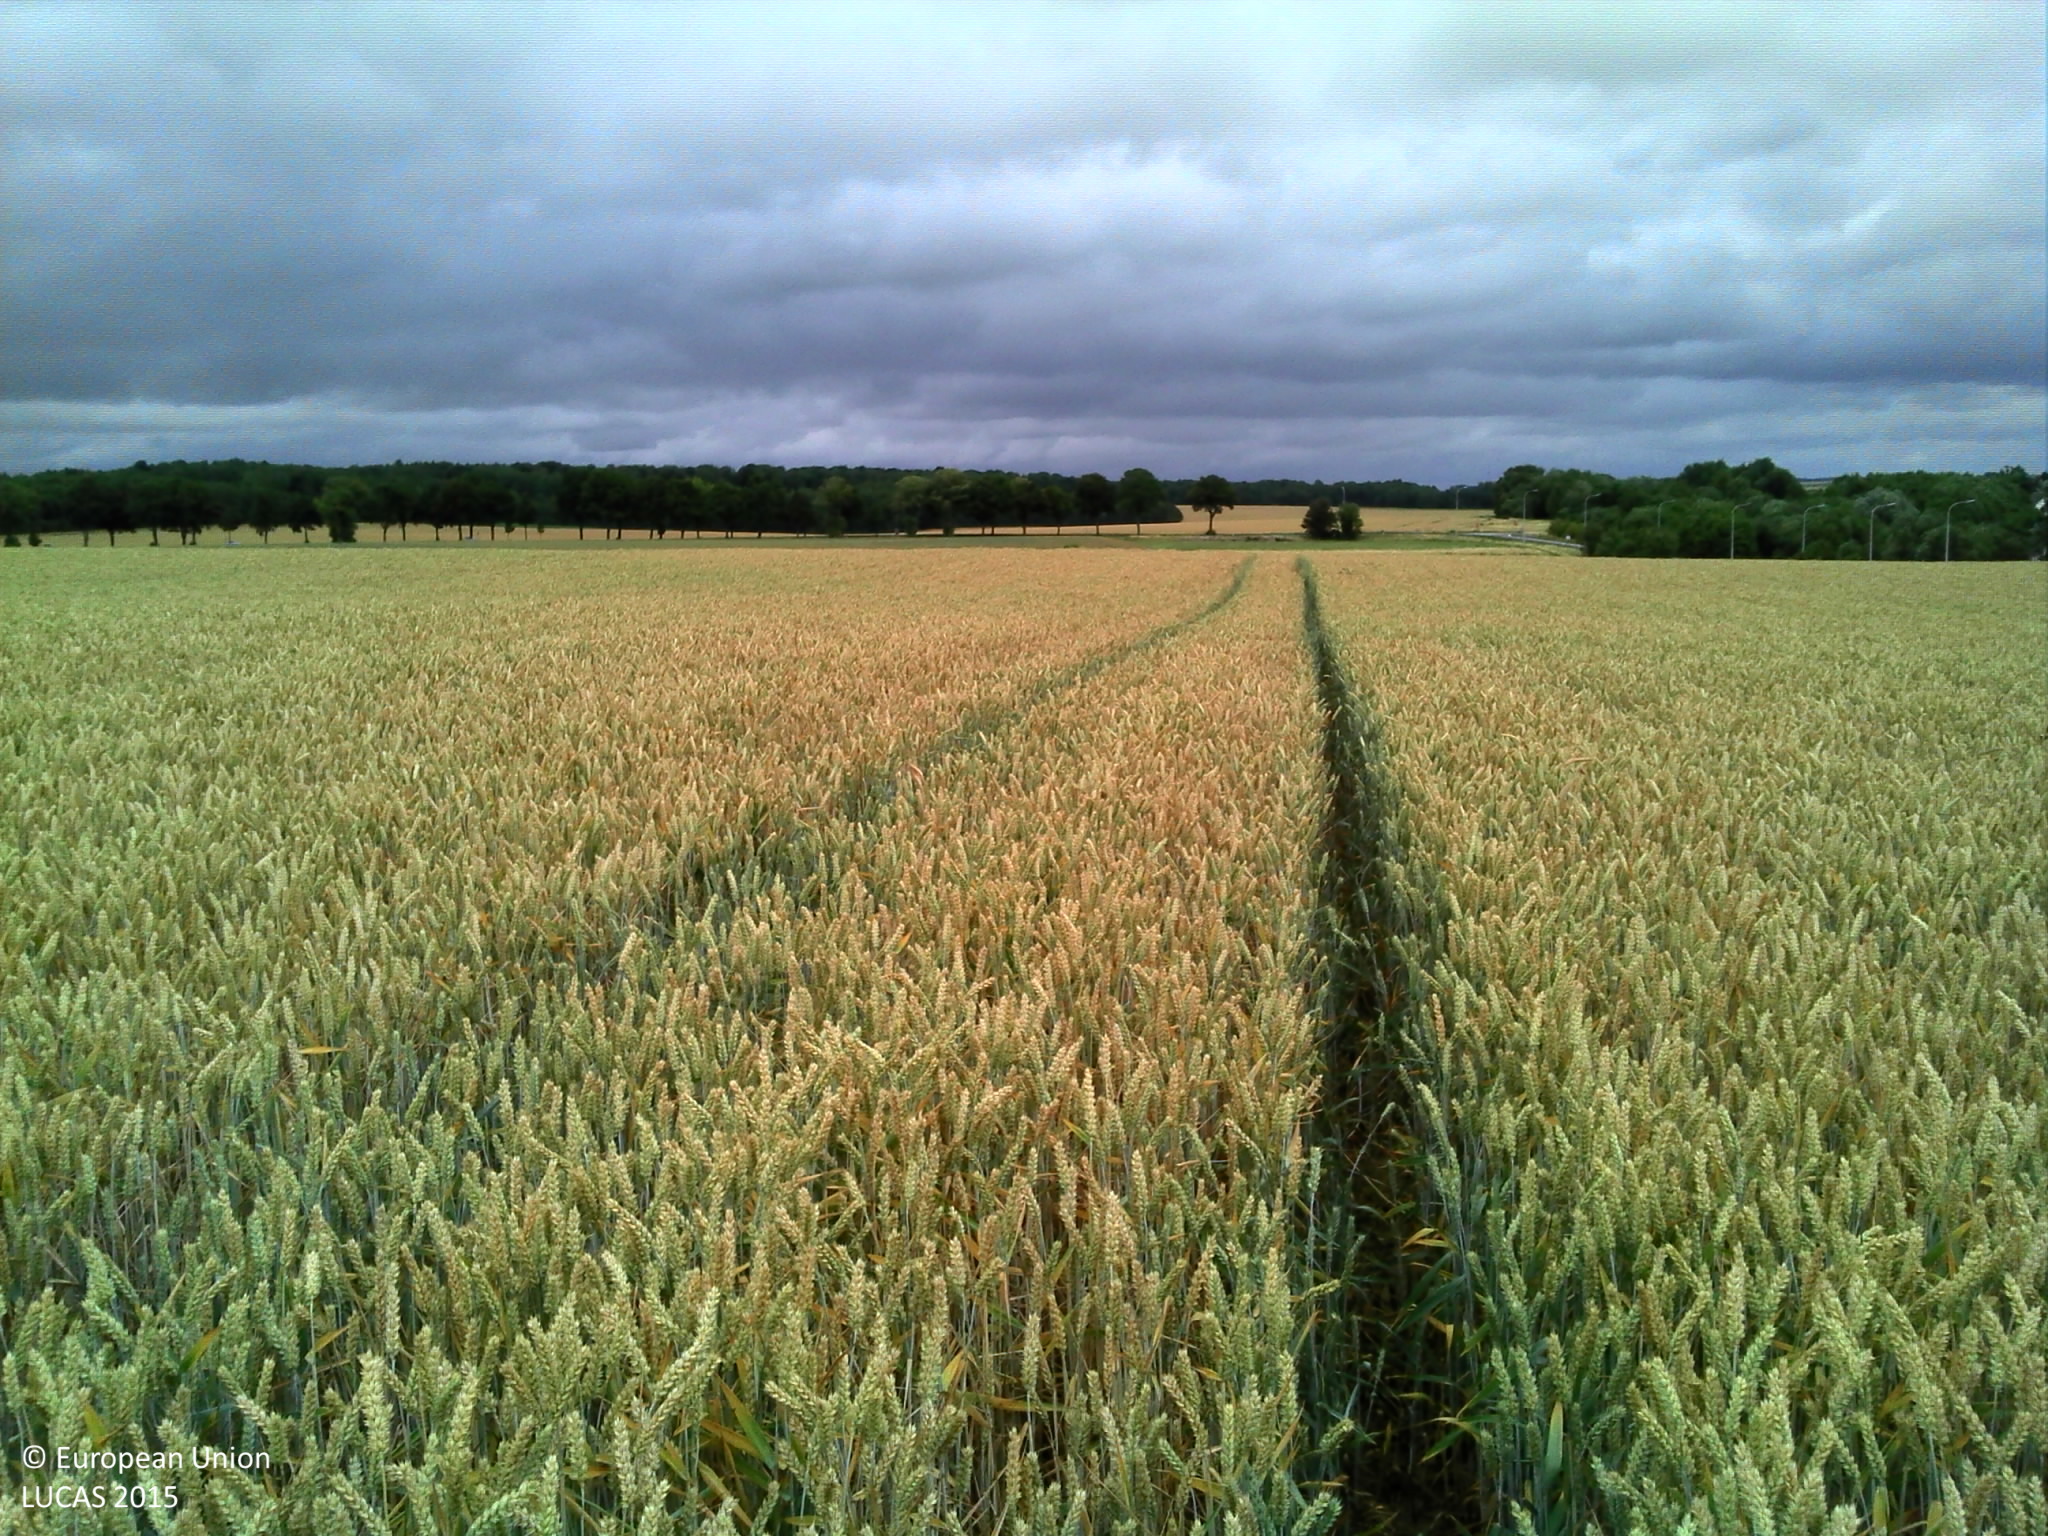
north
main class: Cropland
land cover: Common wheat
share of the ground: > 75 %
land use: Agriculture (excluding fallow land and kitchen gardens)
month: July
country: BE
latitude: 50.3205
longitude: 4.1098
